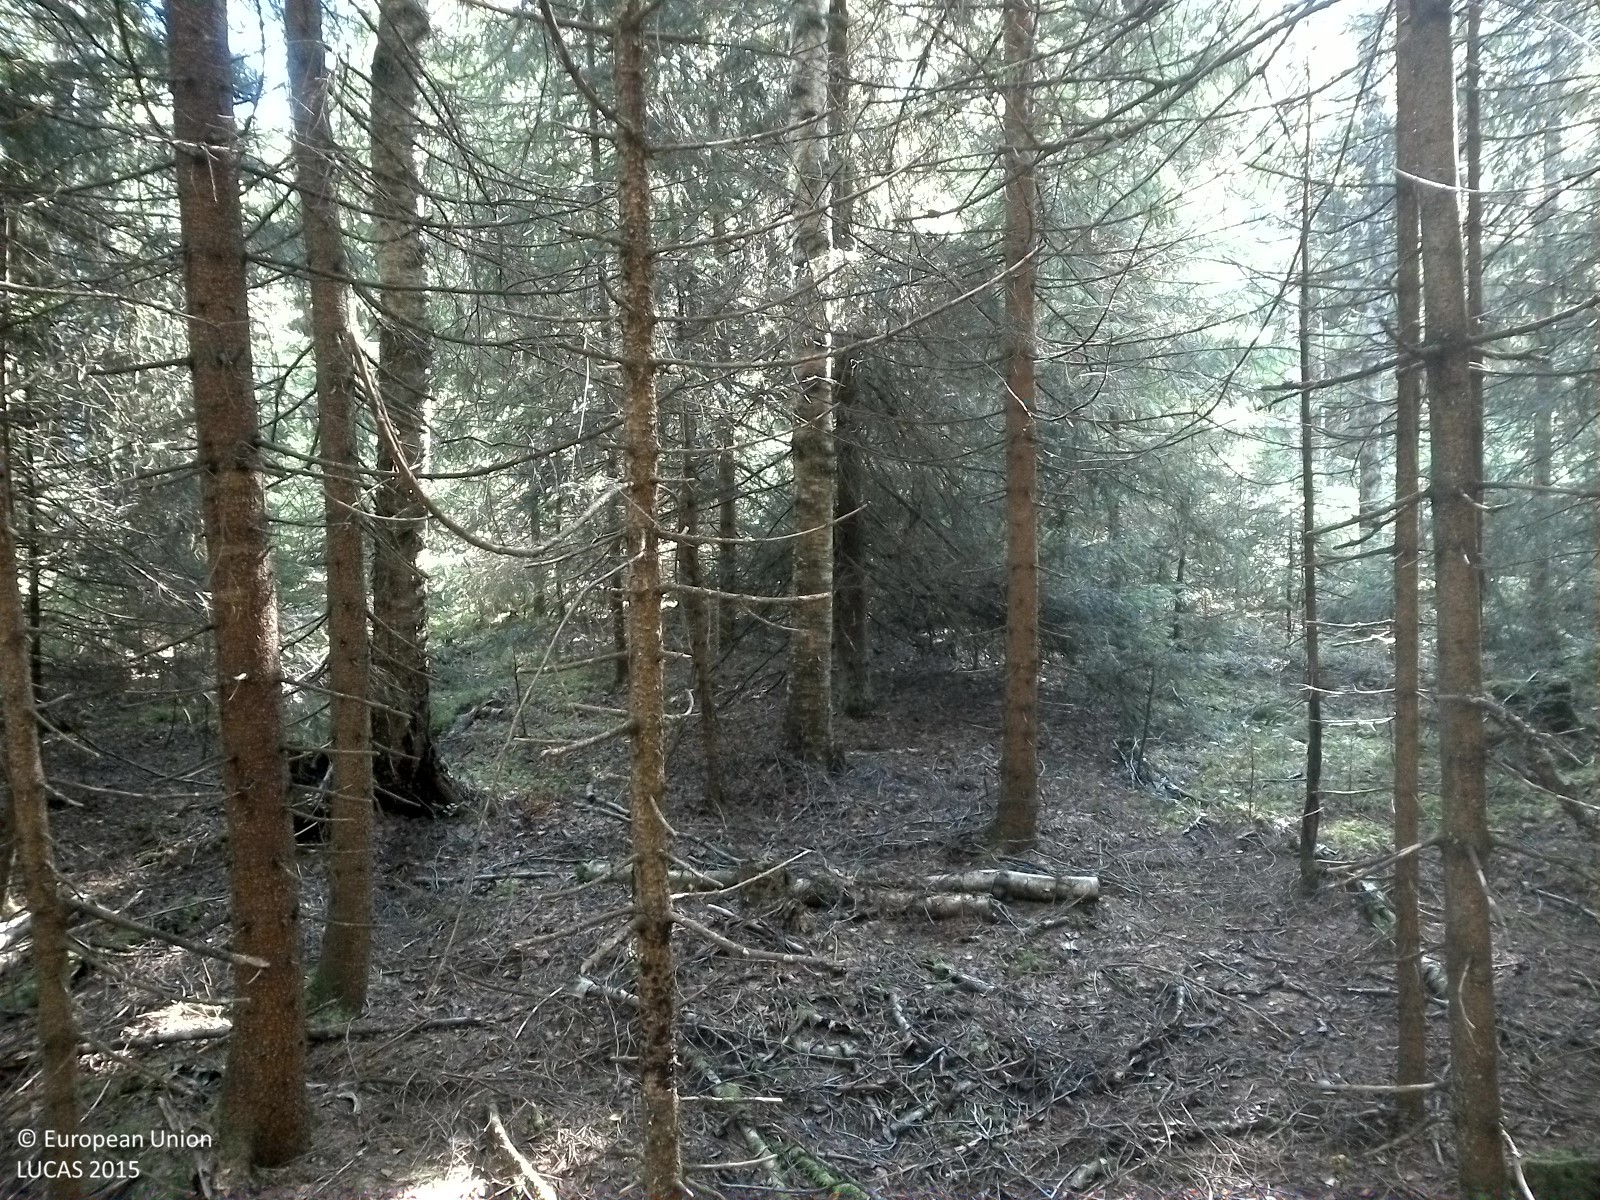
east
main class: Woodland
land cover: Spruce dominated mixed woodland
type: boreal forest
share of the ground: 50 - 75 %
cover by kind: coniferous forest trees 45 %, lichens and mosses 20 %, broadleaved forest trees 15 %, herbaceous plants 10 %, consolidated bare surface 10 %
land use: Forestry
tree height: < 5 m
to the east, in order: Spruce dominated mixed woodland; Tracks; Spruce dominated mixed woodland; Ditches and canals; Spontaneously vegetated surfaces; Broadleaved woodland; Pine dominated coniferous woodland; Grass margins; Paved roads, cycling and walking lanes; Grassland without tree/shrub cover
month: August
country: SE
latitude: 58.7913
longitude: 15.0626
